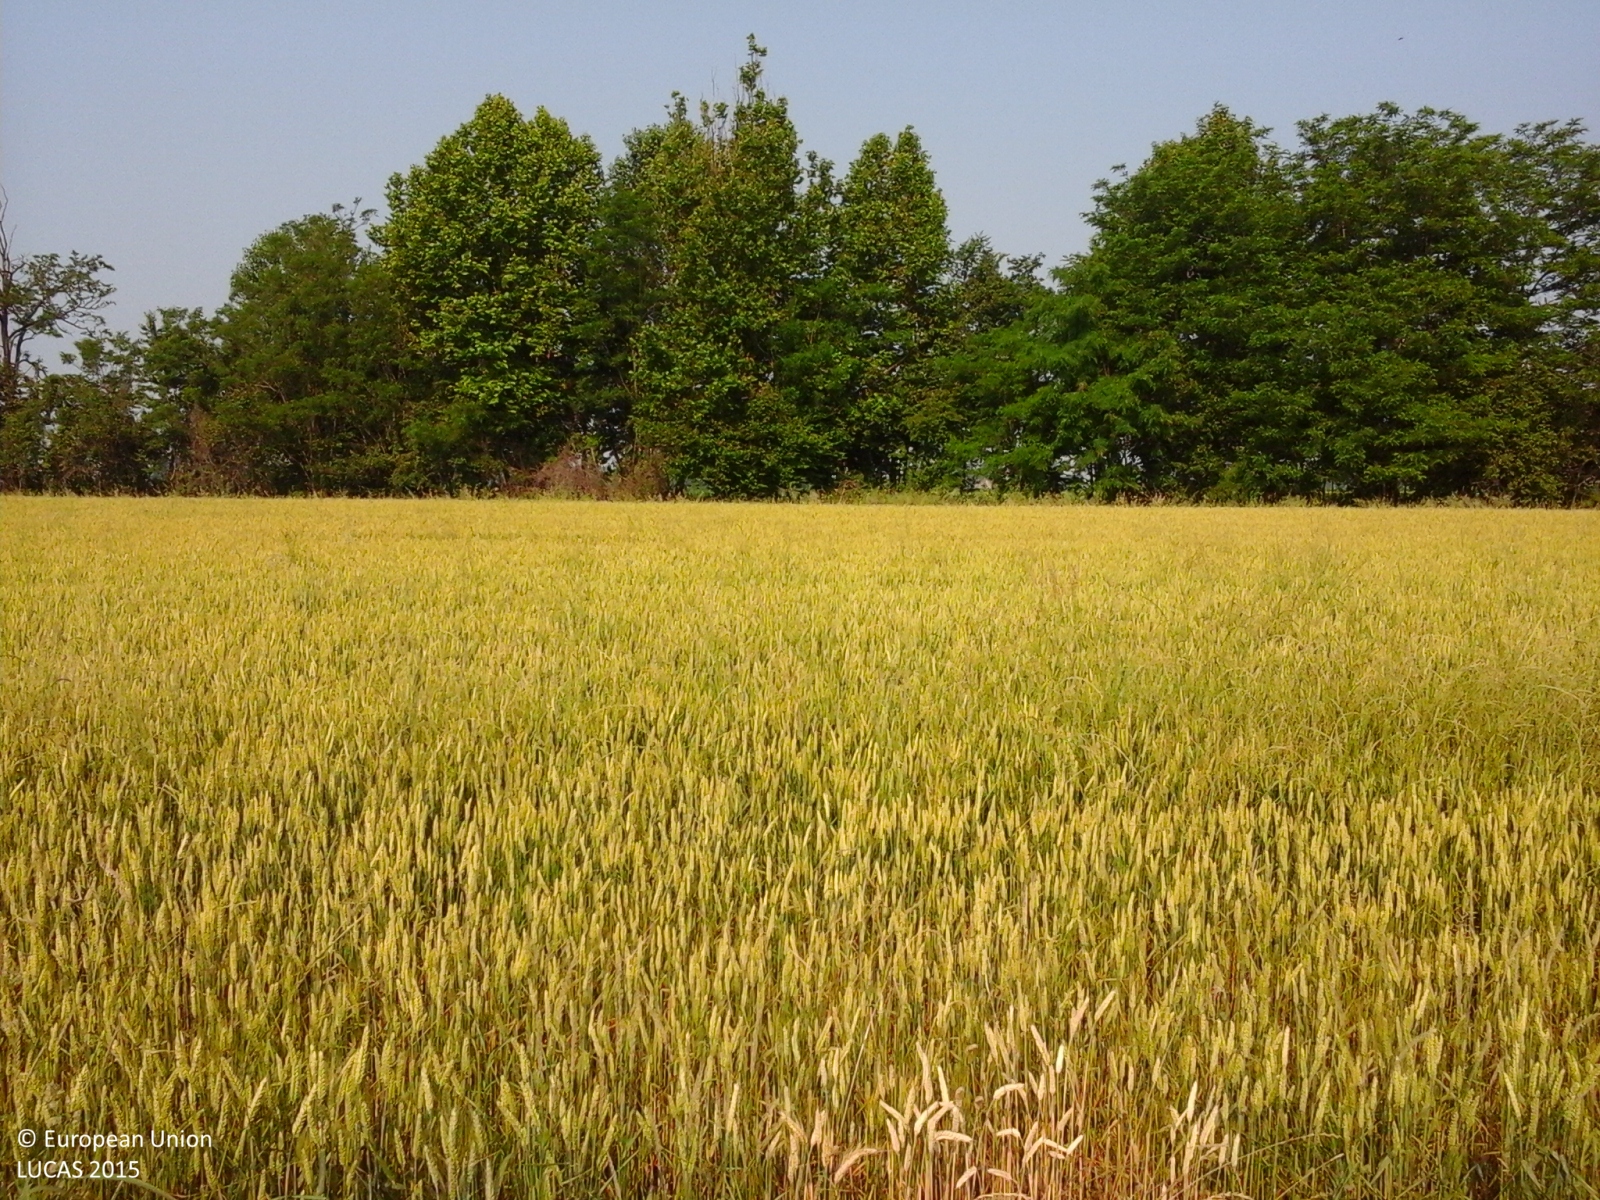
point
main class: Cropland
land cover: Common wheat
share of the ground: > 75 %
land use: Agriculture (excluding fallow land and kitchen gardens)
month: June
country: IT
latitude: 45.4683
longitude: 9.8595
